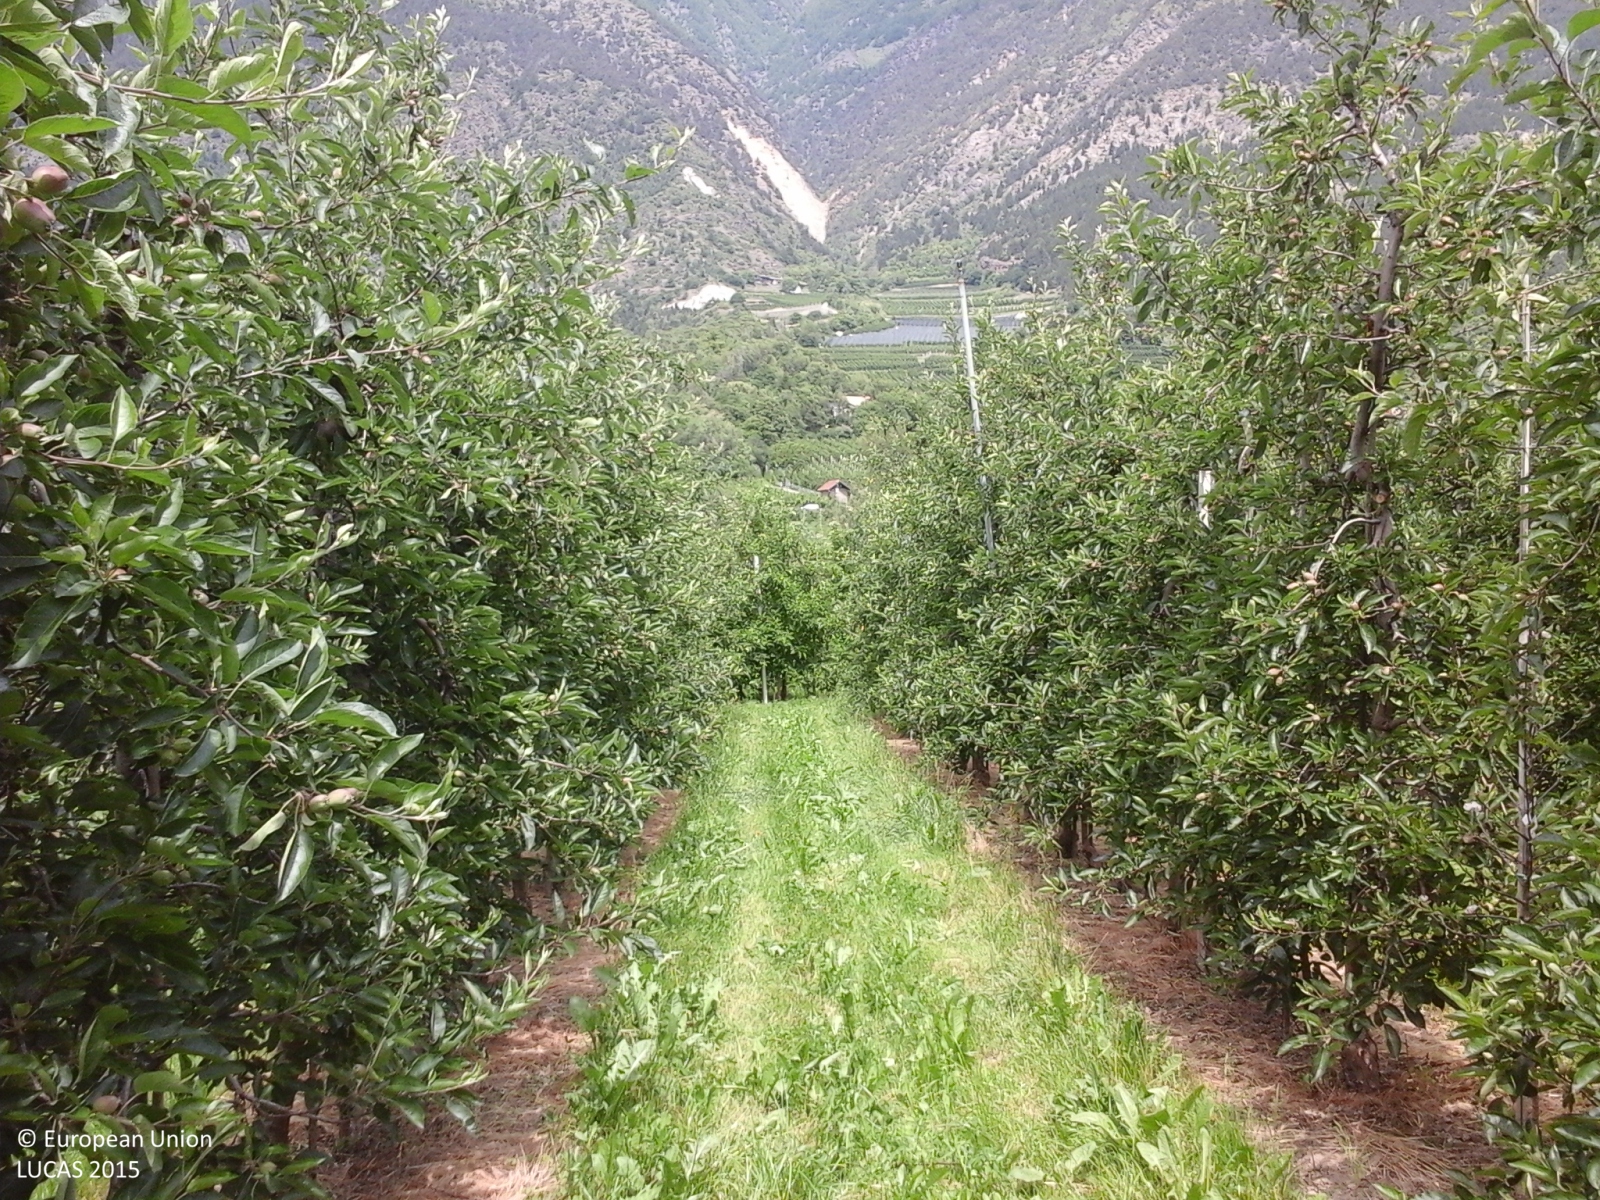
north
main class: Cropland
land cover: Apple fruit
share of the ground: > 75 %
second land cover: Grassland without tree/shrub cover
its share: > 75 %
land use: Agriculture (excluding fallow land and kitchen gardens)
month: May
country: IT
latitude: 46.6182
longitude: 10.8217
